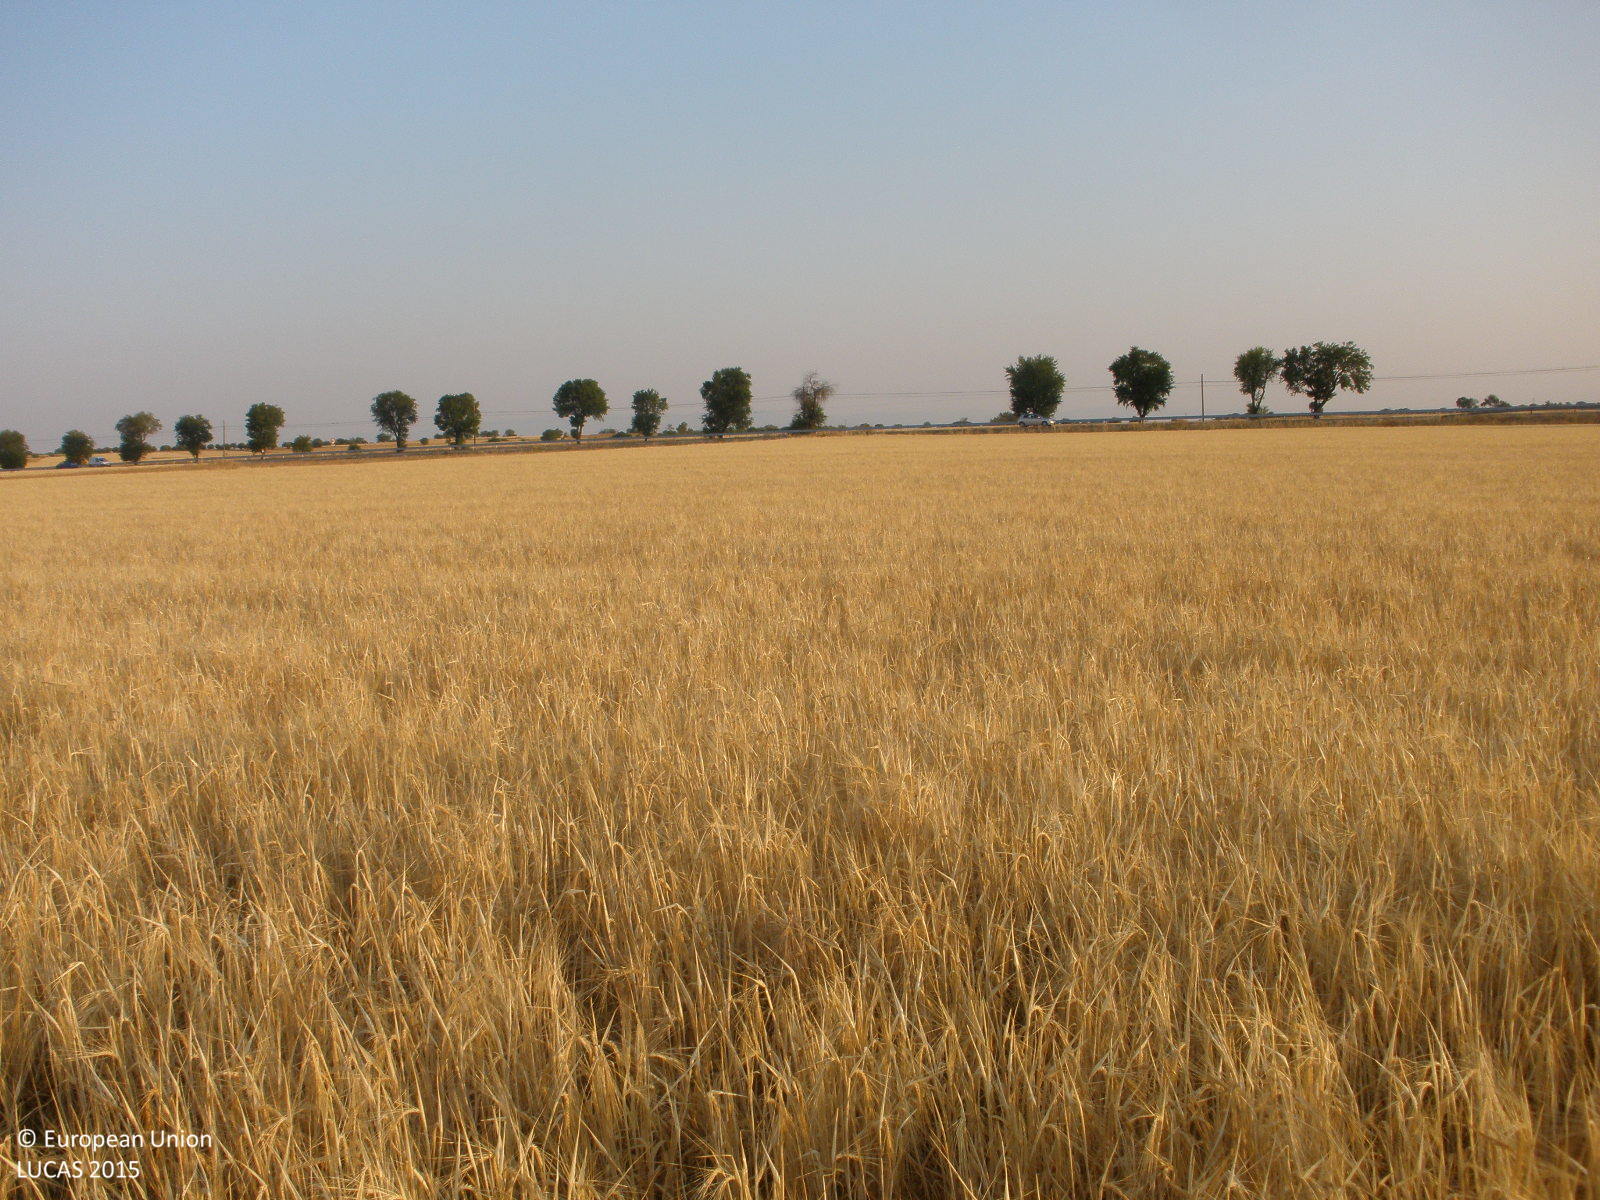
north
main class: Cropland
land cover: Barley
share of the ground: > 75 %
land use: Agriculture (excluding fallow land and kitchen gardens)
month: June
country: ES
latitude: 40.3397
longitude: -3.3459
